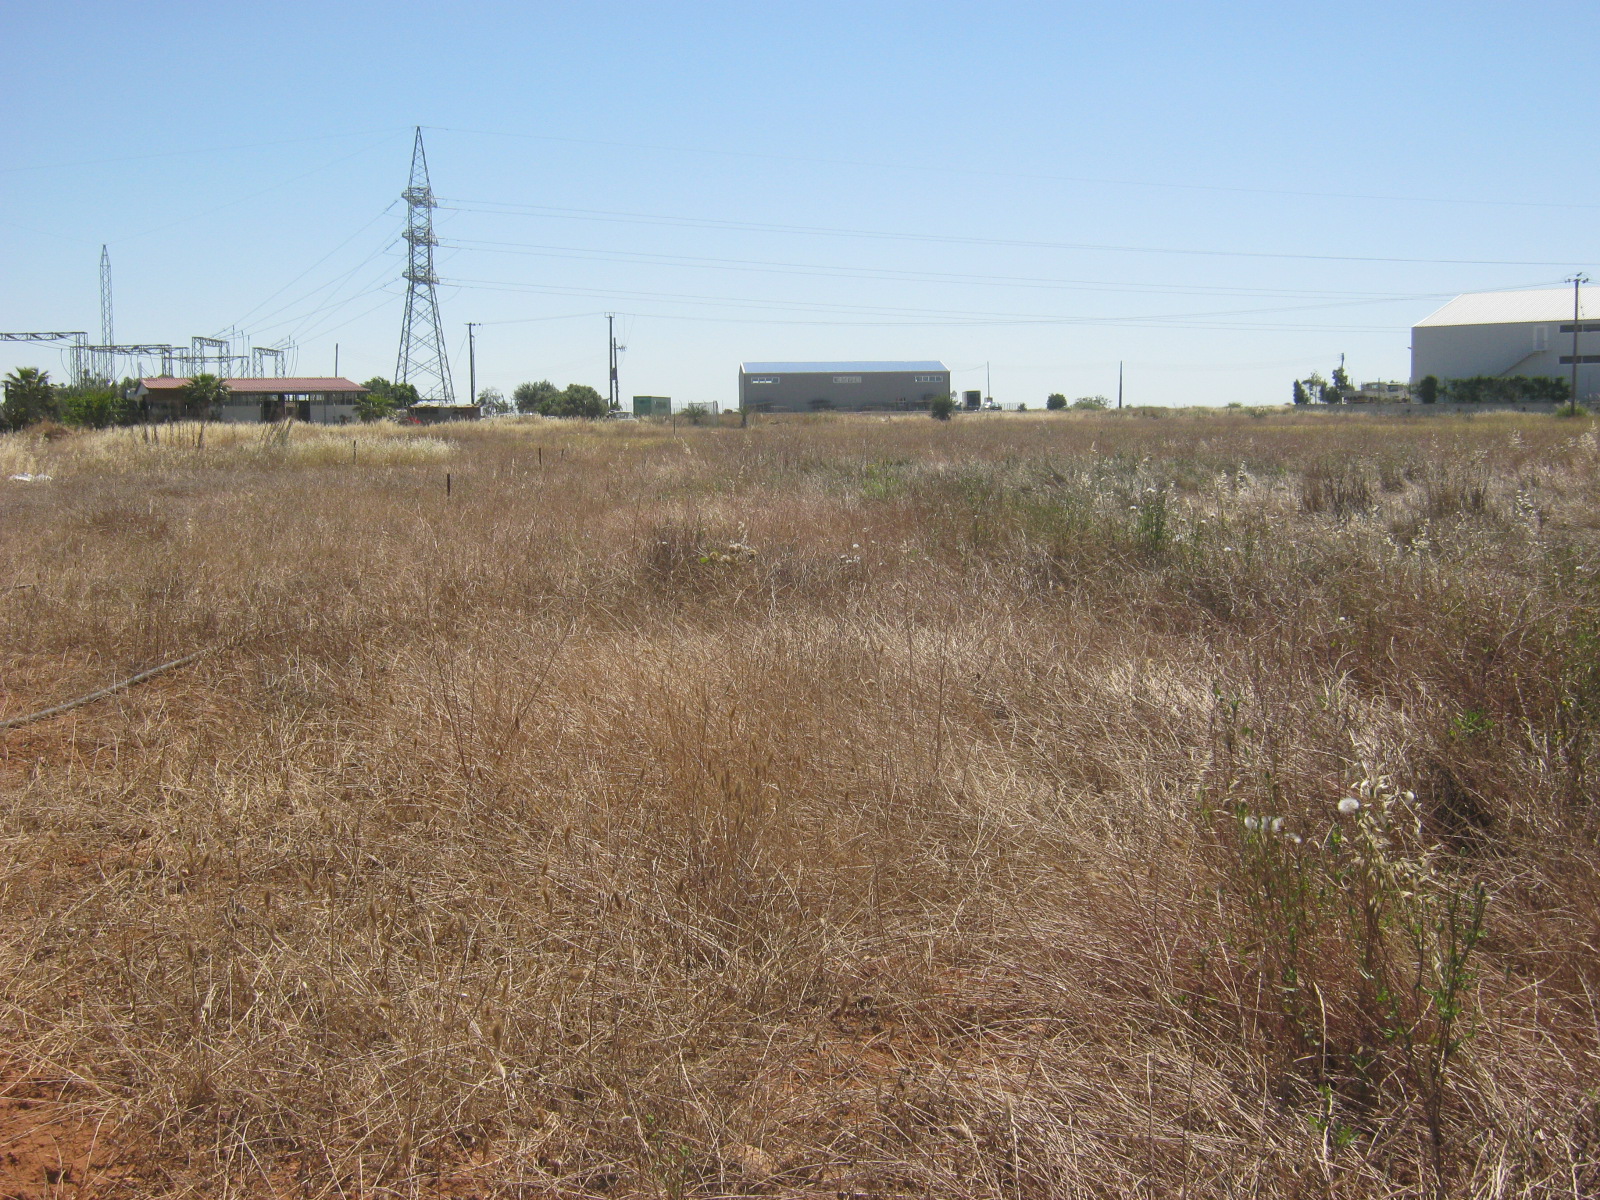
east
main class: Grassland
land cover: Grassland without tree/shrub cover
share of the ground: 50 - 75 %
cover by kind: herbaceous plants 65 %, unconsolidated bare surface 30 %, shrubs 5 %
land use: Semi-natural and natural areas not in use
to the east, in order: Grassland without tree/shrub cover; Tracks; Grassland without tree/shrub cover; Tracks; Artificial constructions in urban areas; Spontaneously vegetated surfaces
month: May
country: CY
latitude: 35.1482
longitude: 33.2277
